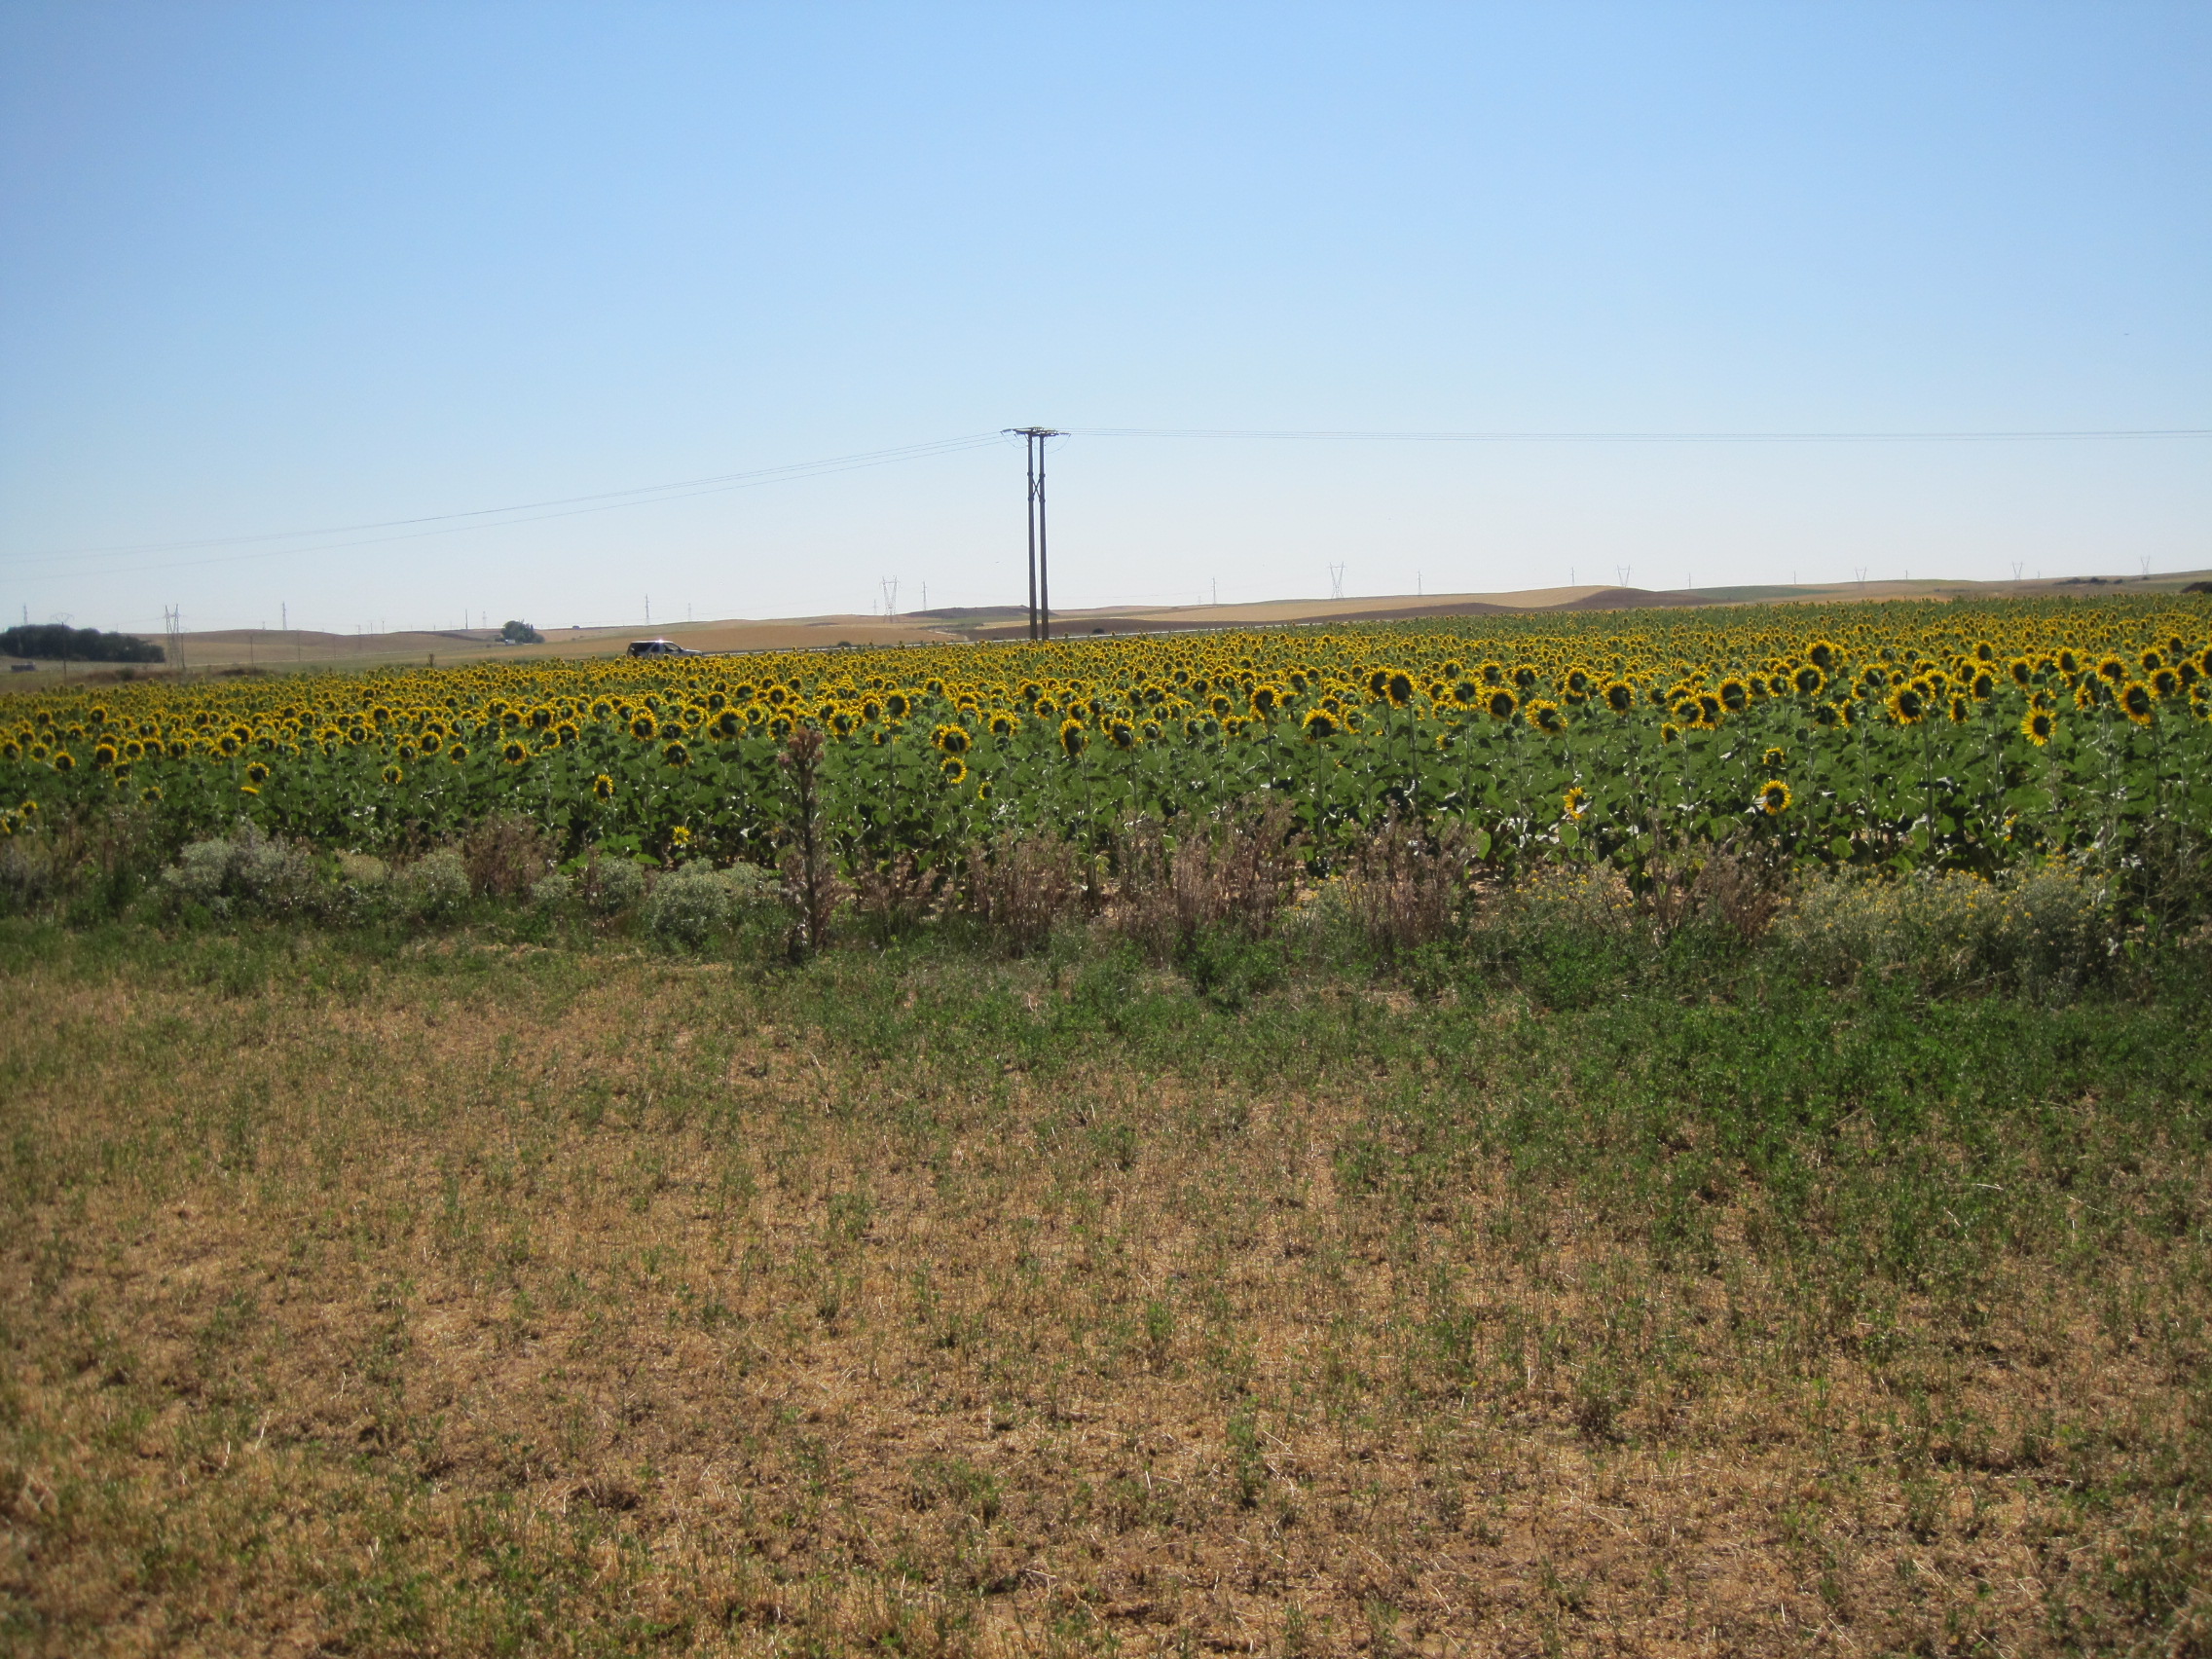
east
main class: Cropland
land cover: Lucerne
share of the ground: 25 - 50 %
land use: Agriculture (excluding fallow land and kitchen gardens)
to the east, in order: Lucerne; Grass margins; Sunflower; Spontaneously vegetated surfaces; Tracks; Spontaneously vegetated surfaces; Electric lines; Spontaneously vegetated surfaces; Common wheat; Grass margins; Rivers and streams; Grass margins; Lucerne
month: July
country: ES
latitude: 42.0851
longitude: -5.2067
